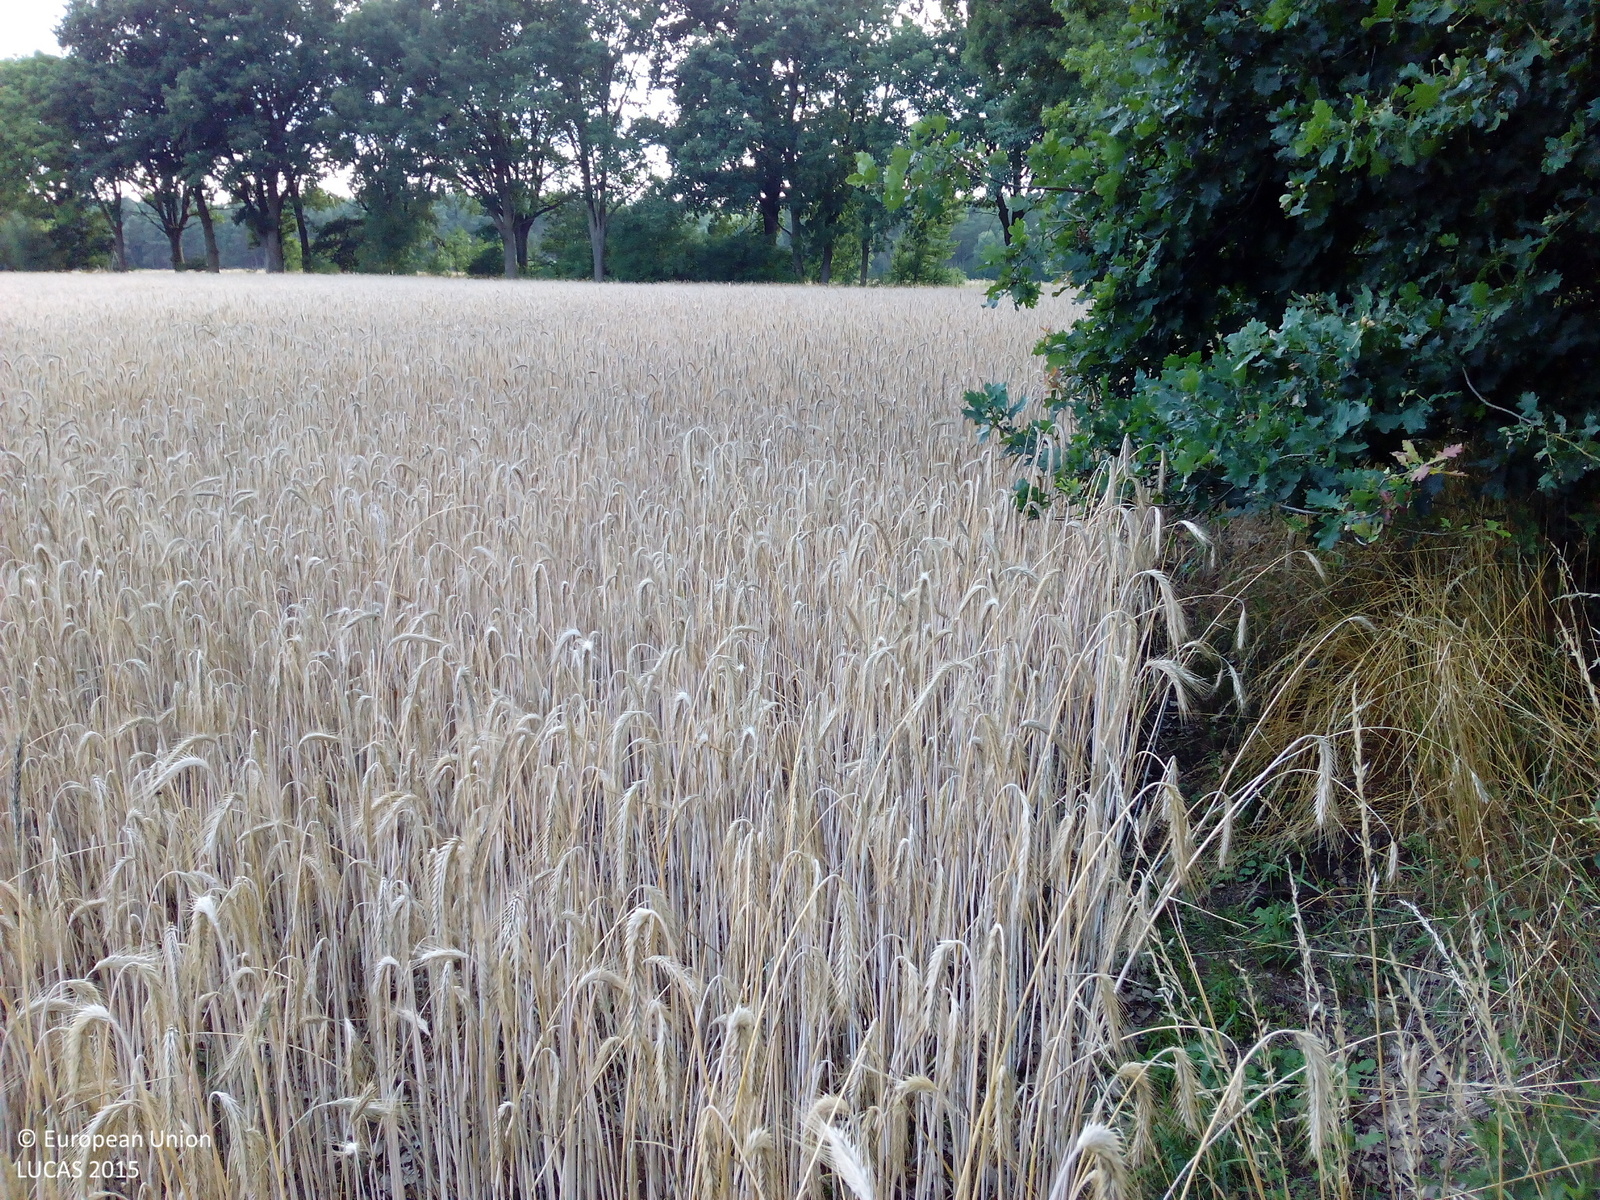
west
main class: Cropland
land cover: Rye
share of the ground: > 75 %
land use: Agriculture (excluding fallow land and kitchen gardens)
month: July
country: DE
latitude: 52.9641
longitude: 12.4262
